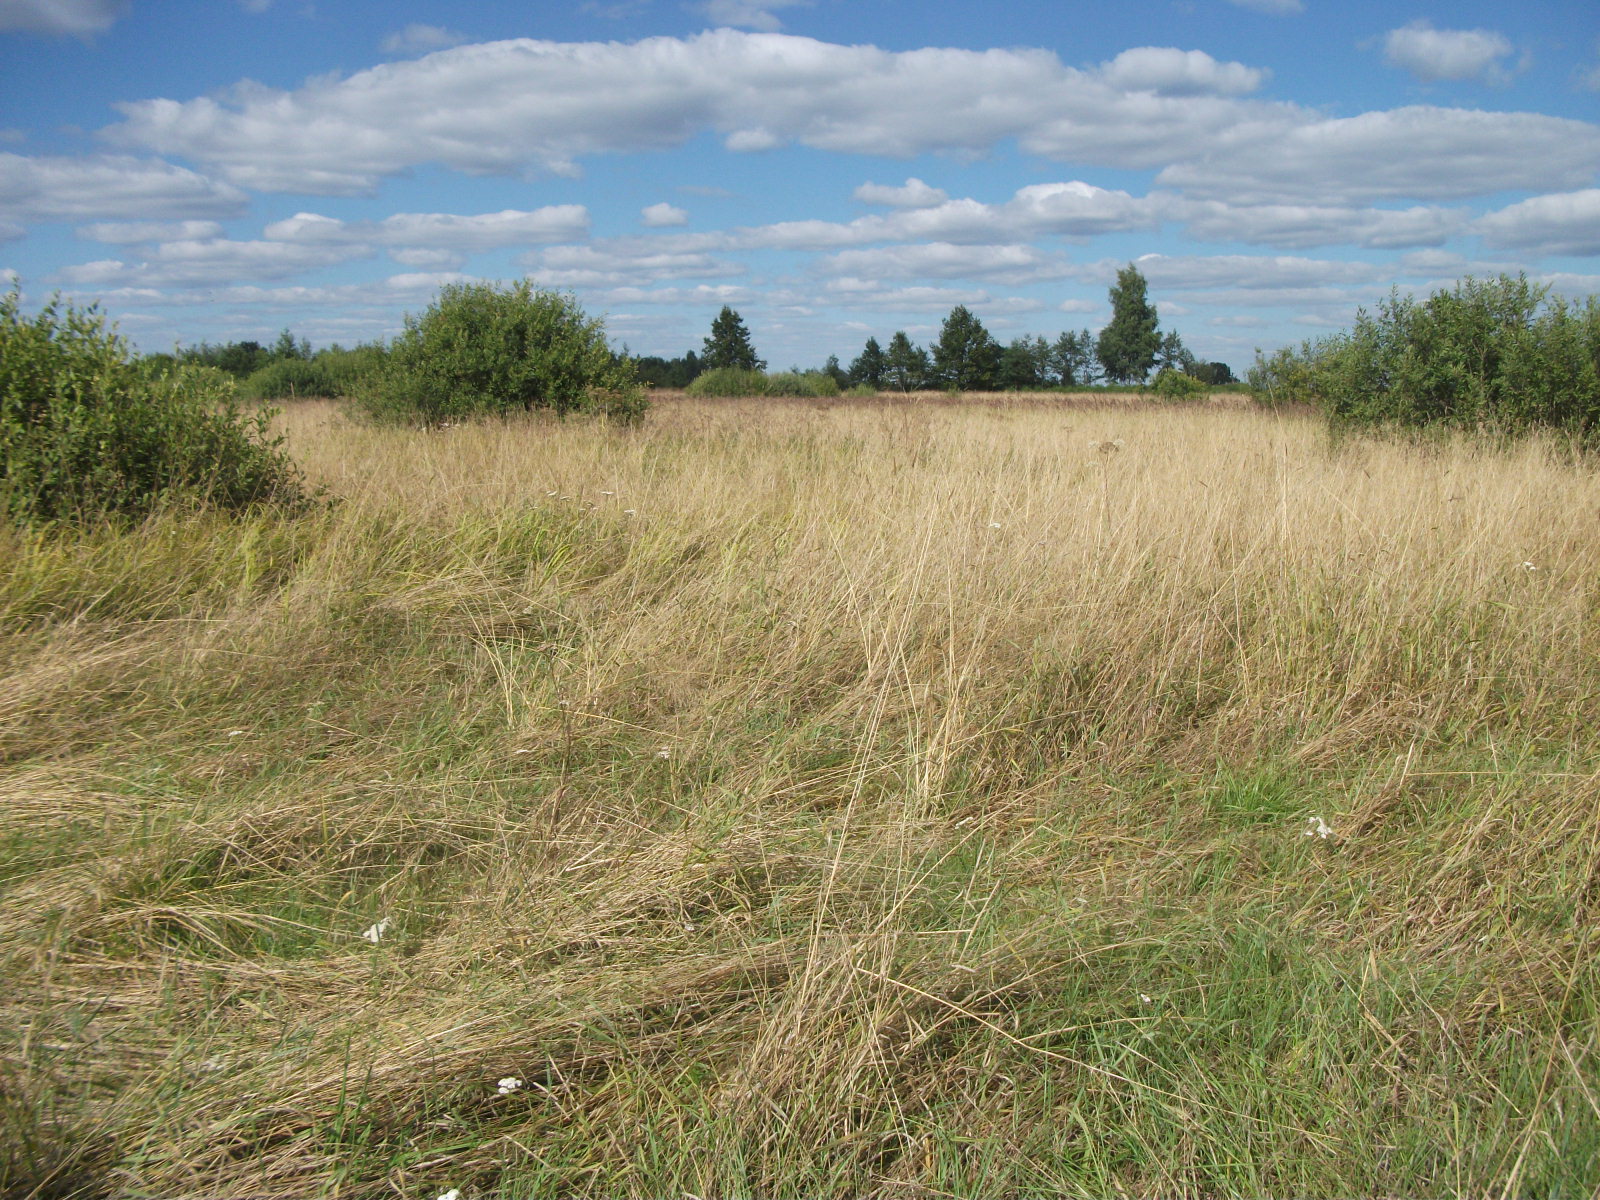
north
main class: Grassland
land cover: Grassland with sparse tree/shrub cover
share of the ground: > 75 %
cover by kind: herbaceous plants 85 %, shrubs 10 %, broadleaved forest trees 5 %
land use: Abandoned areas
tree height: < 5 m
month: August
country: LV
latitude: 56.4095
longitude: 26.4007
